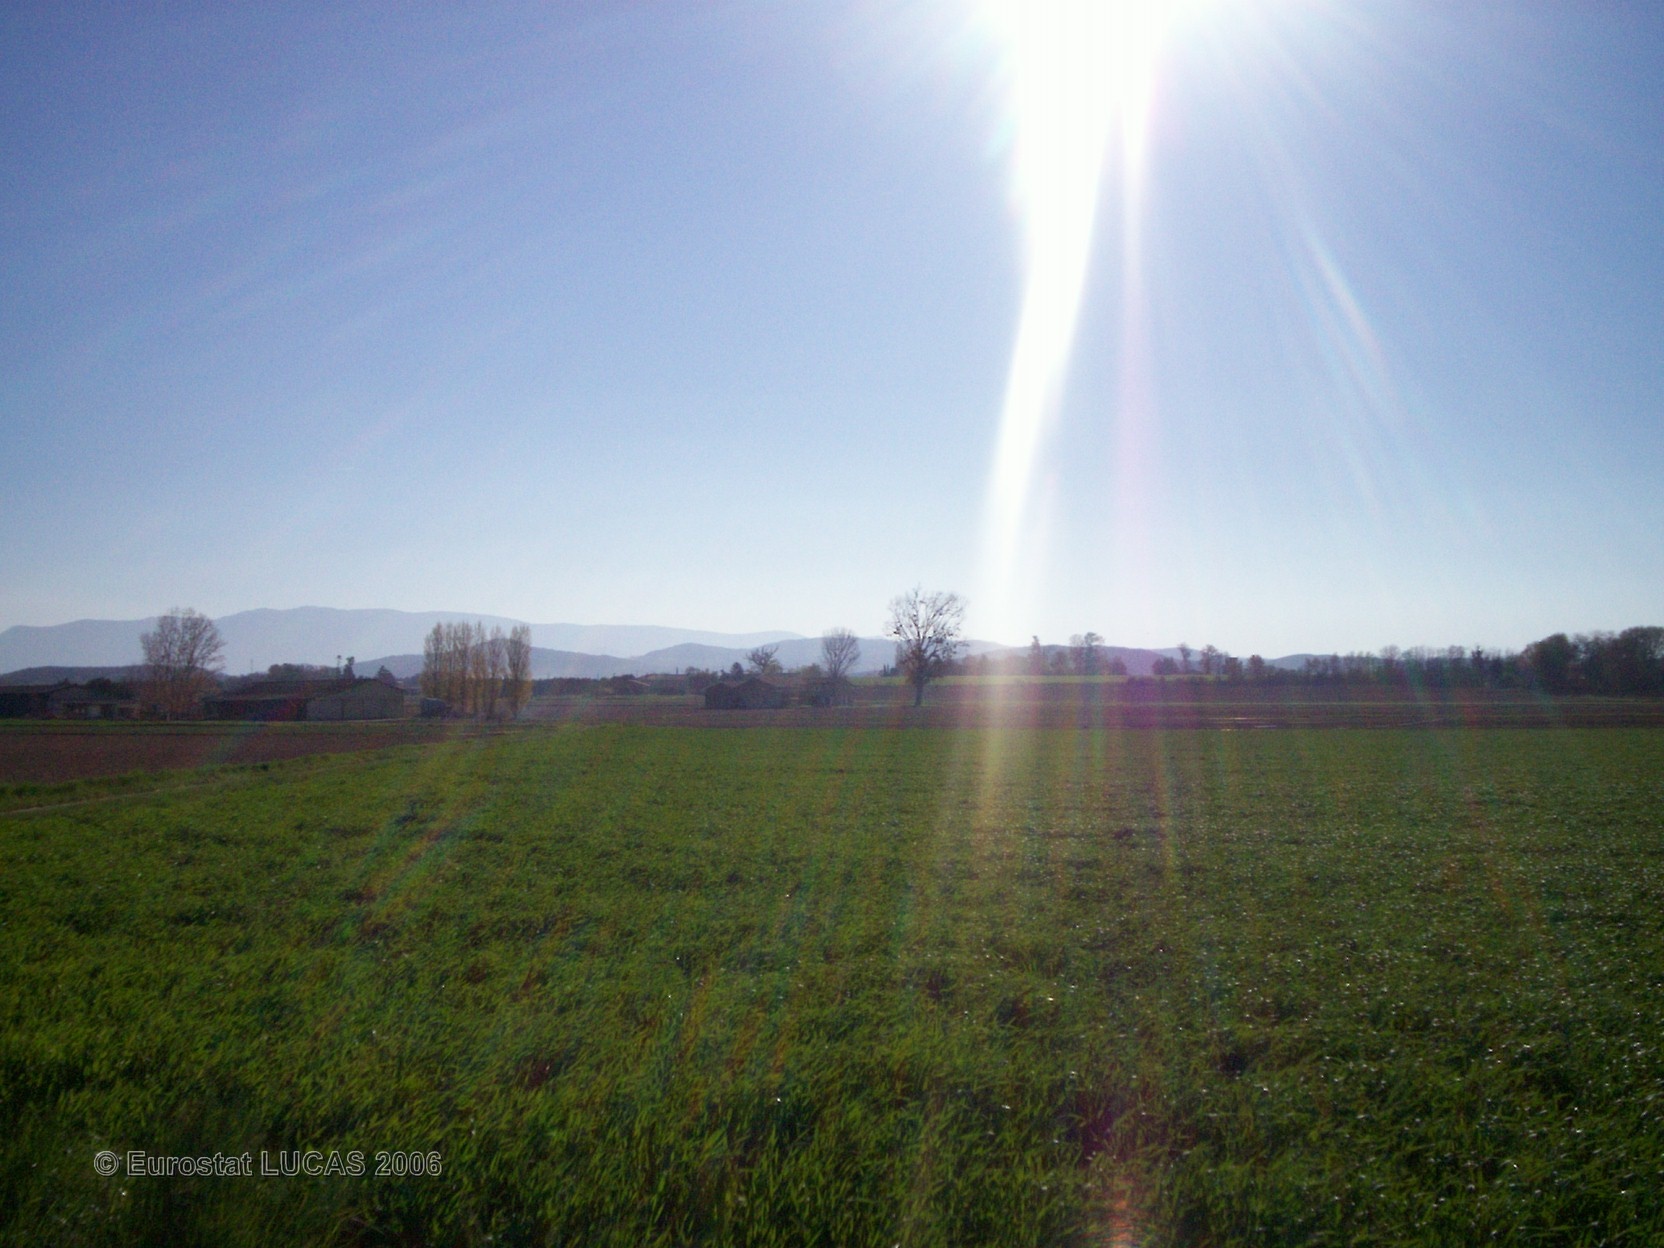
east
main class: Grassland
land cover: Grassland without tree/shrub cover
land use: Agriculture (excluding fallow land and kitchen gardens)
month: April
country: FR
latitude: 44.7858
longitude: 4.9127
